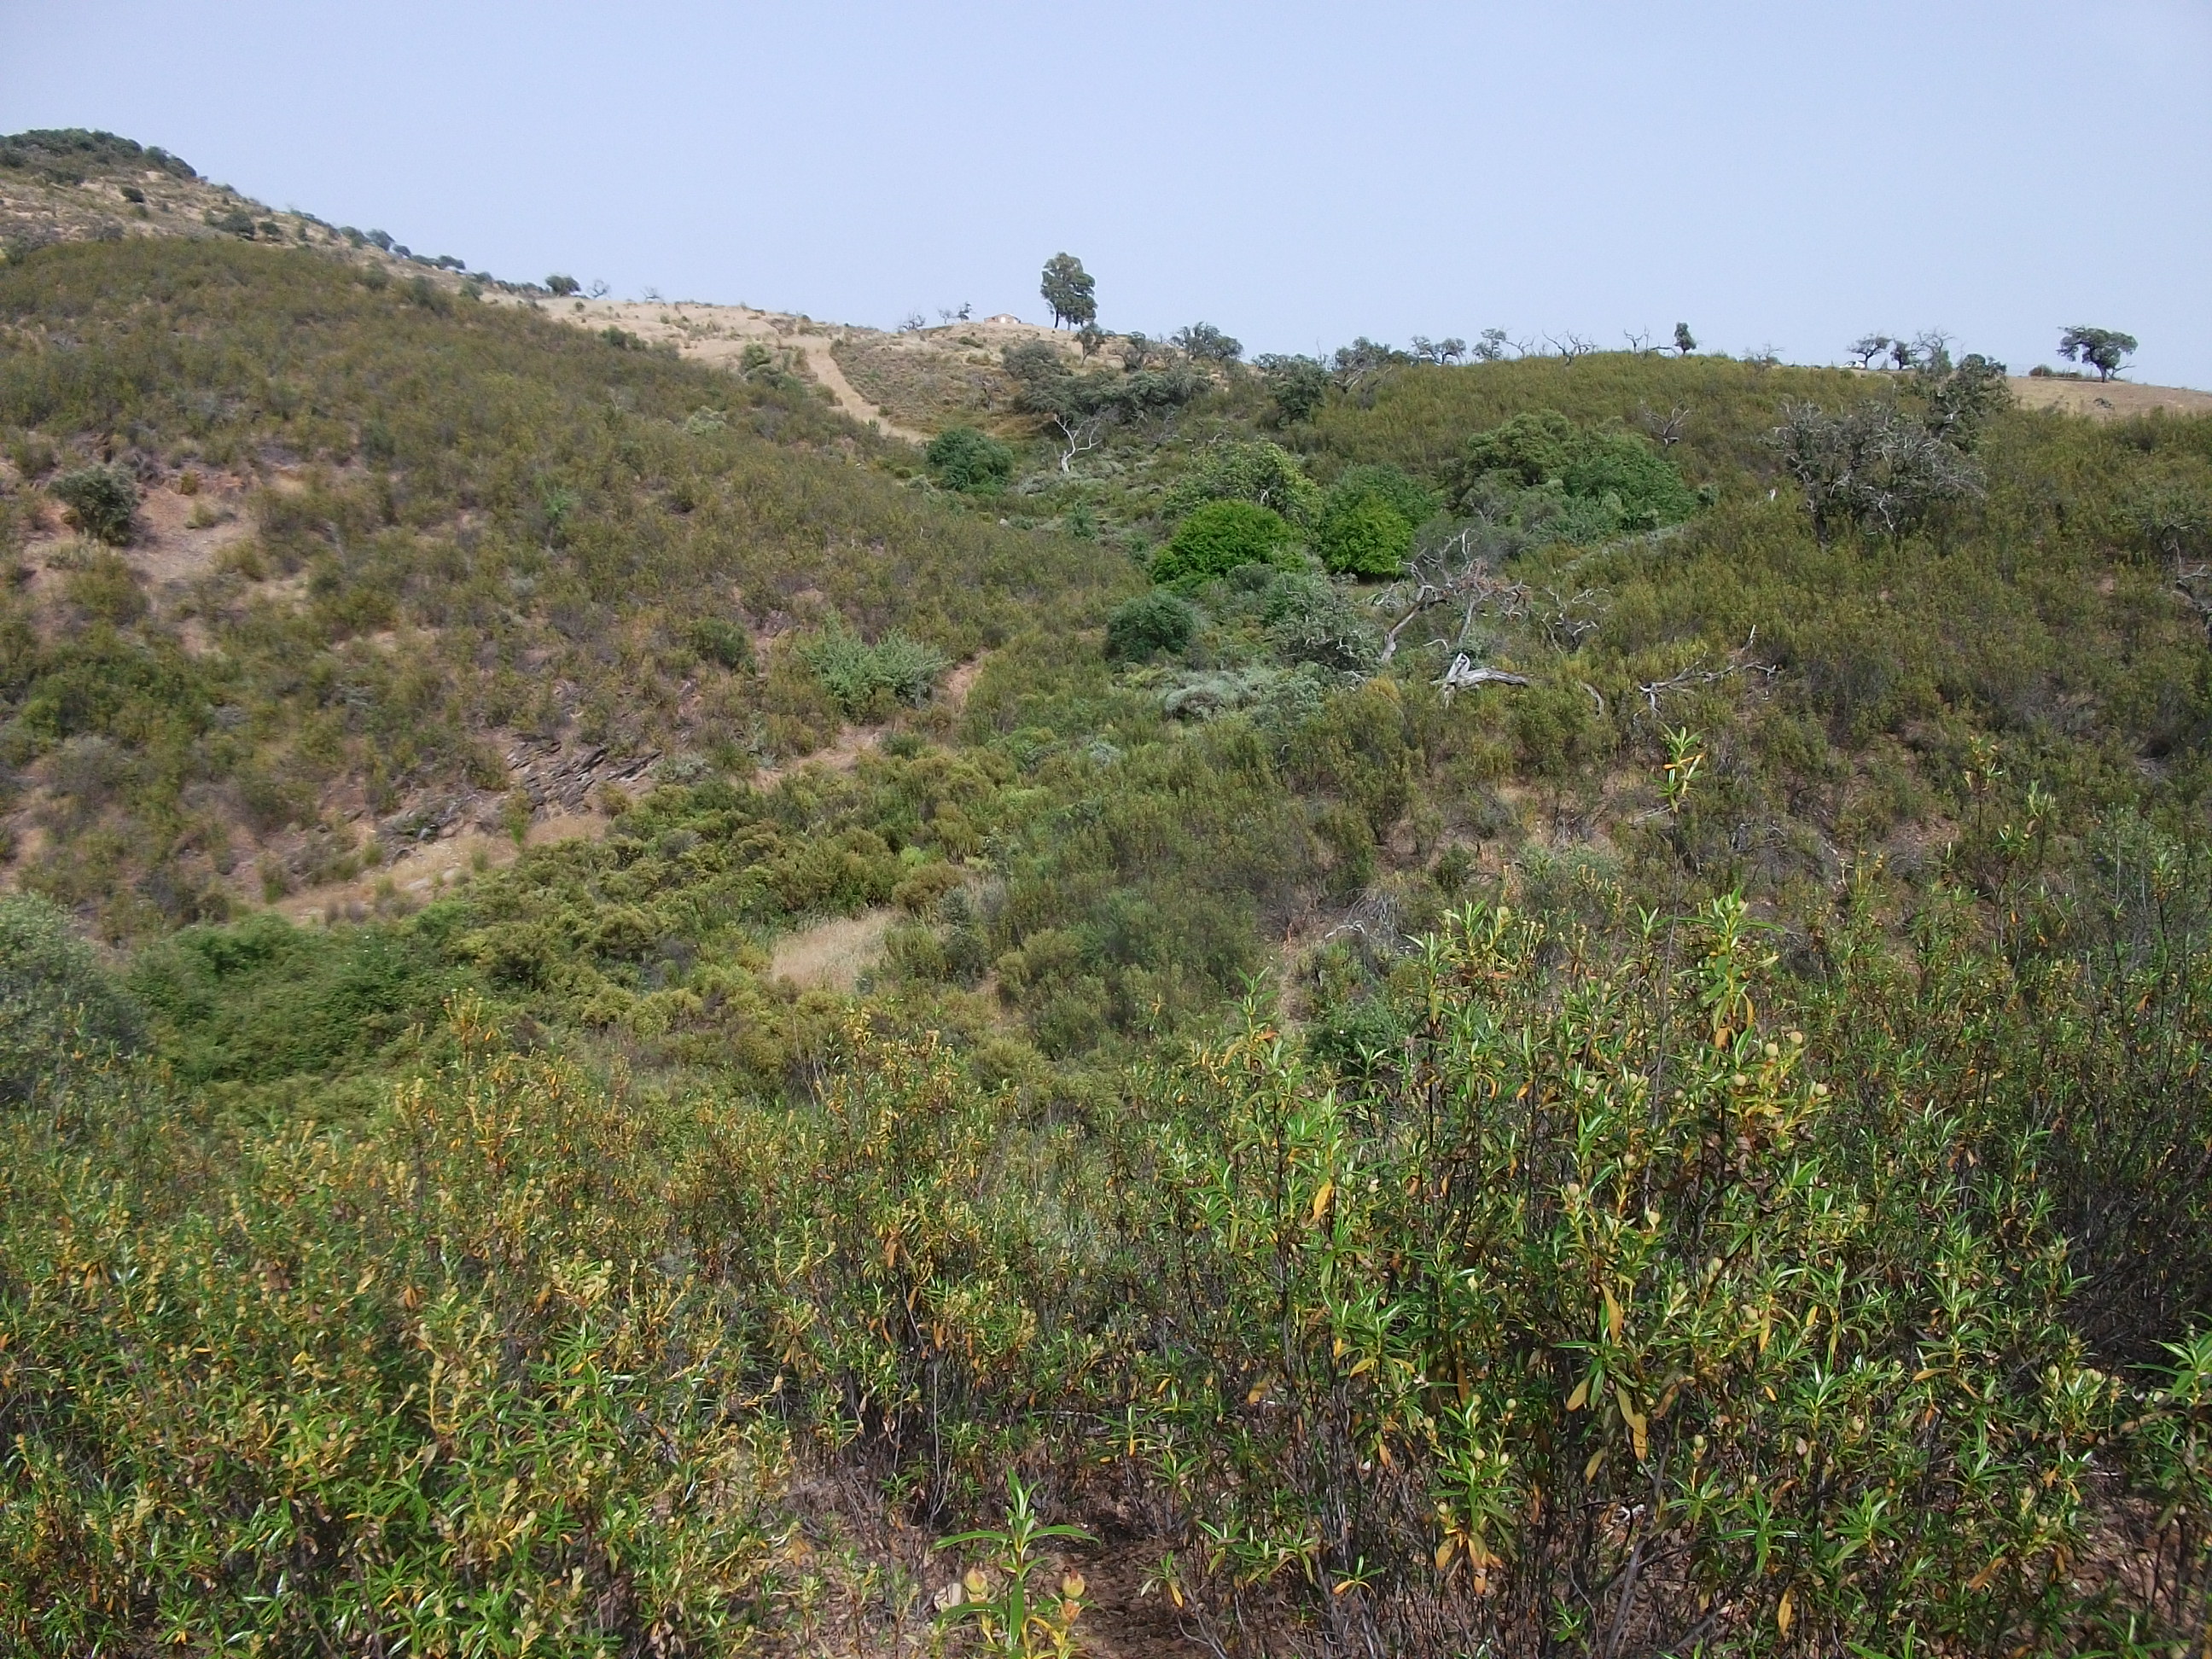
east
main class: Woodland
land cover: Broadleaved woodland
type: broadleaved evergreen forest
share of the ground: 10 - 25 %
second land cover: Spontaneously vegetated surfaces
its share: > 75 %
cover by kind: shrubs 90 %, broadleaved forest trees 10 %
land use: Agriculture (excluding fallow land and kitchen gardens)
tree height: > 5 m
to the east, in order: Broadleaved woodland; Spontaneously vegetated surfaces; Shrubland with sparse tree cover; Rivers and streams; Shrubland without tree cover; Broadleaved woodland; Fences; Broadleaved woodland
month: May
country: ES
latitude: 37.6826
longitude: -6.9999
